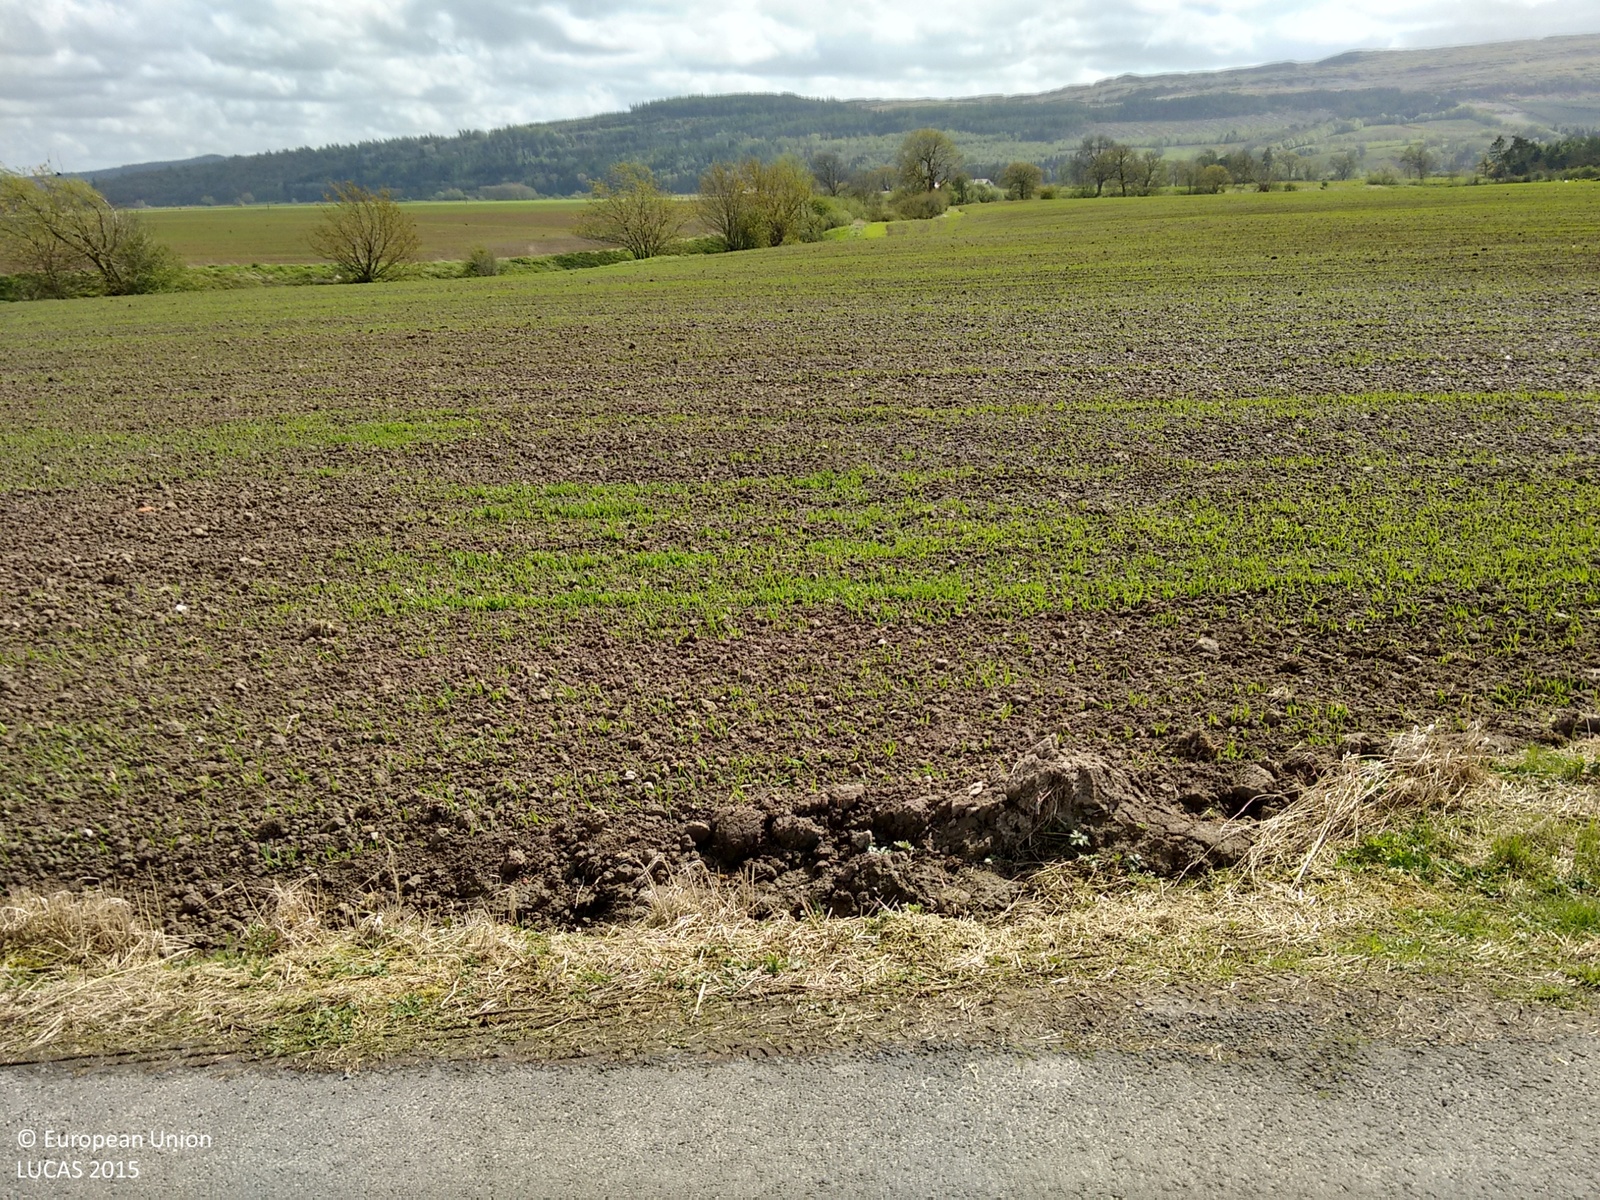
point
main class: Cropland
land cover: Barley
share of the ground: 10 - 25 %
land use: Agriculture (excluding fallow land and kitchen gardens)
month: May
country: GB
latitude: 56.1418
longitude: -4.0408
